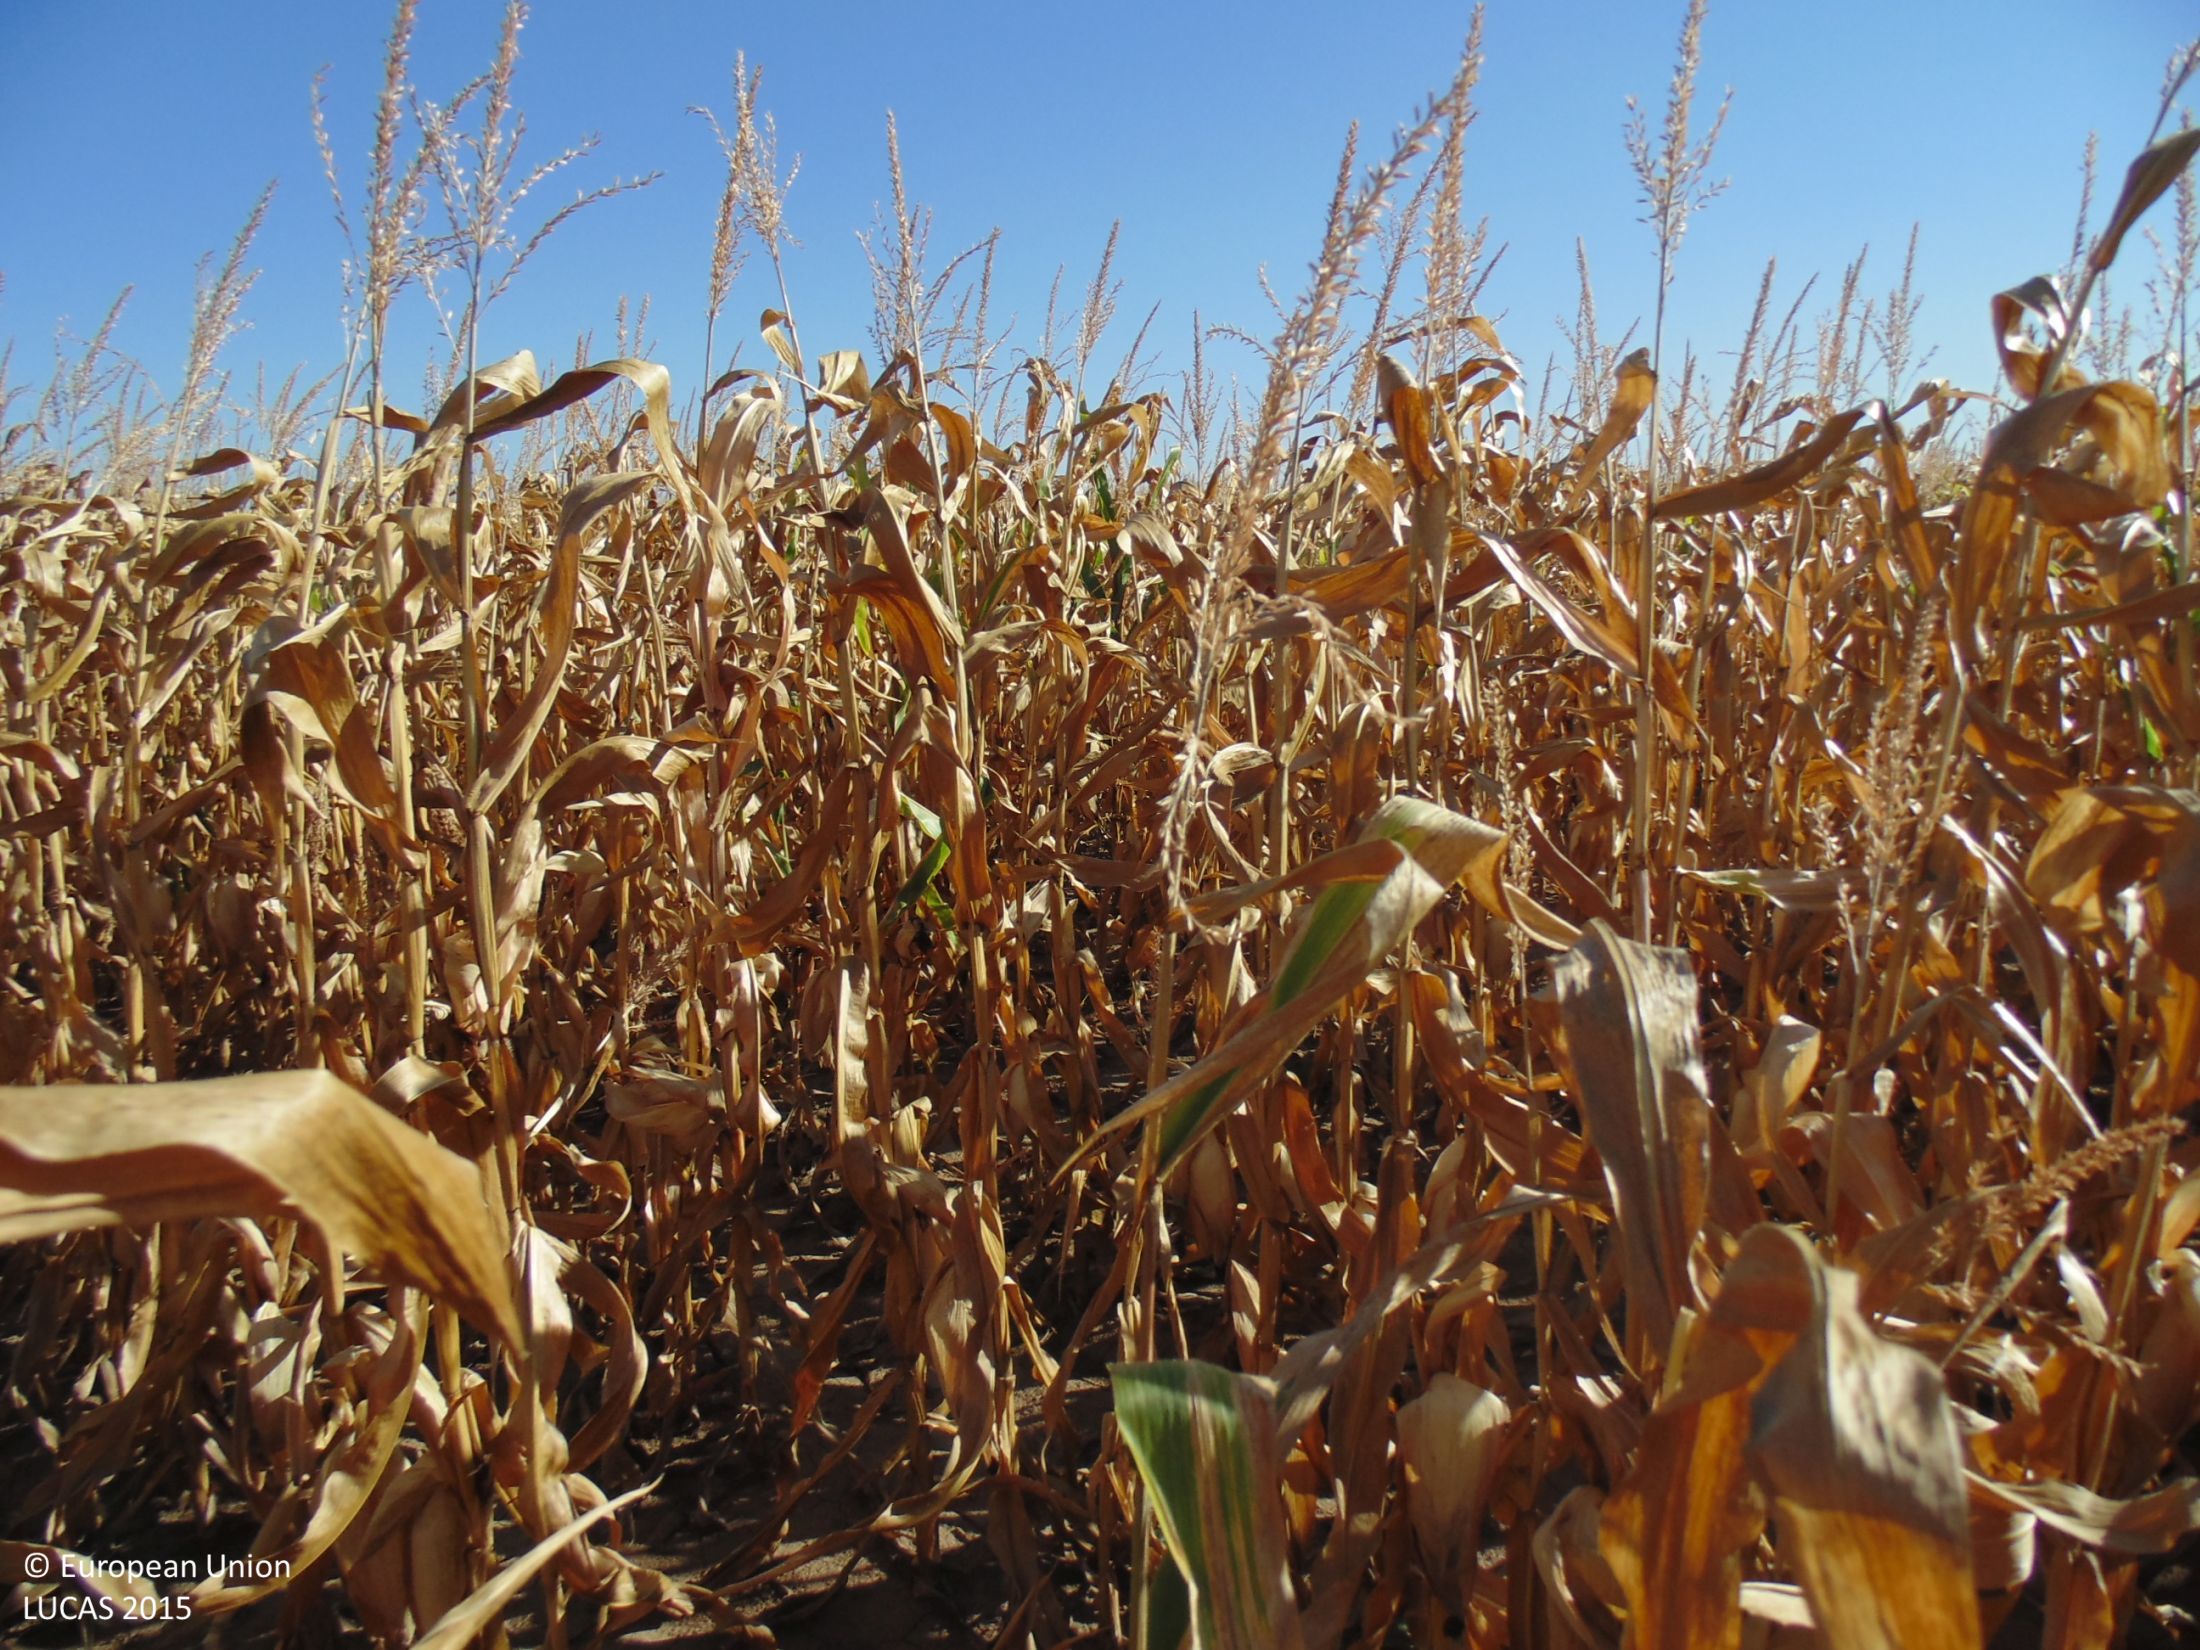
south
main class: Cropland
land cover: Maize
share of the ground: > 75 %
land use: Agriculture (excluding fallow land and kitchen gardens)
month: September
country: BG
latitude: 43.6860
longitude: 27.1313
